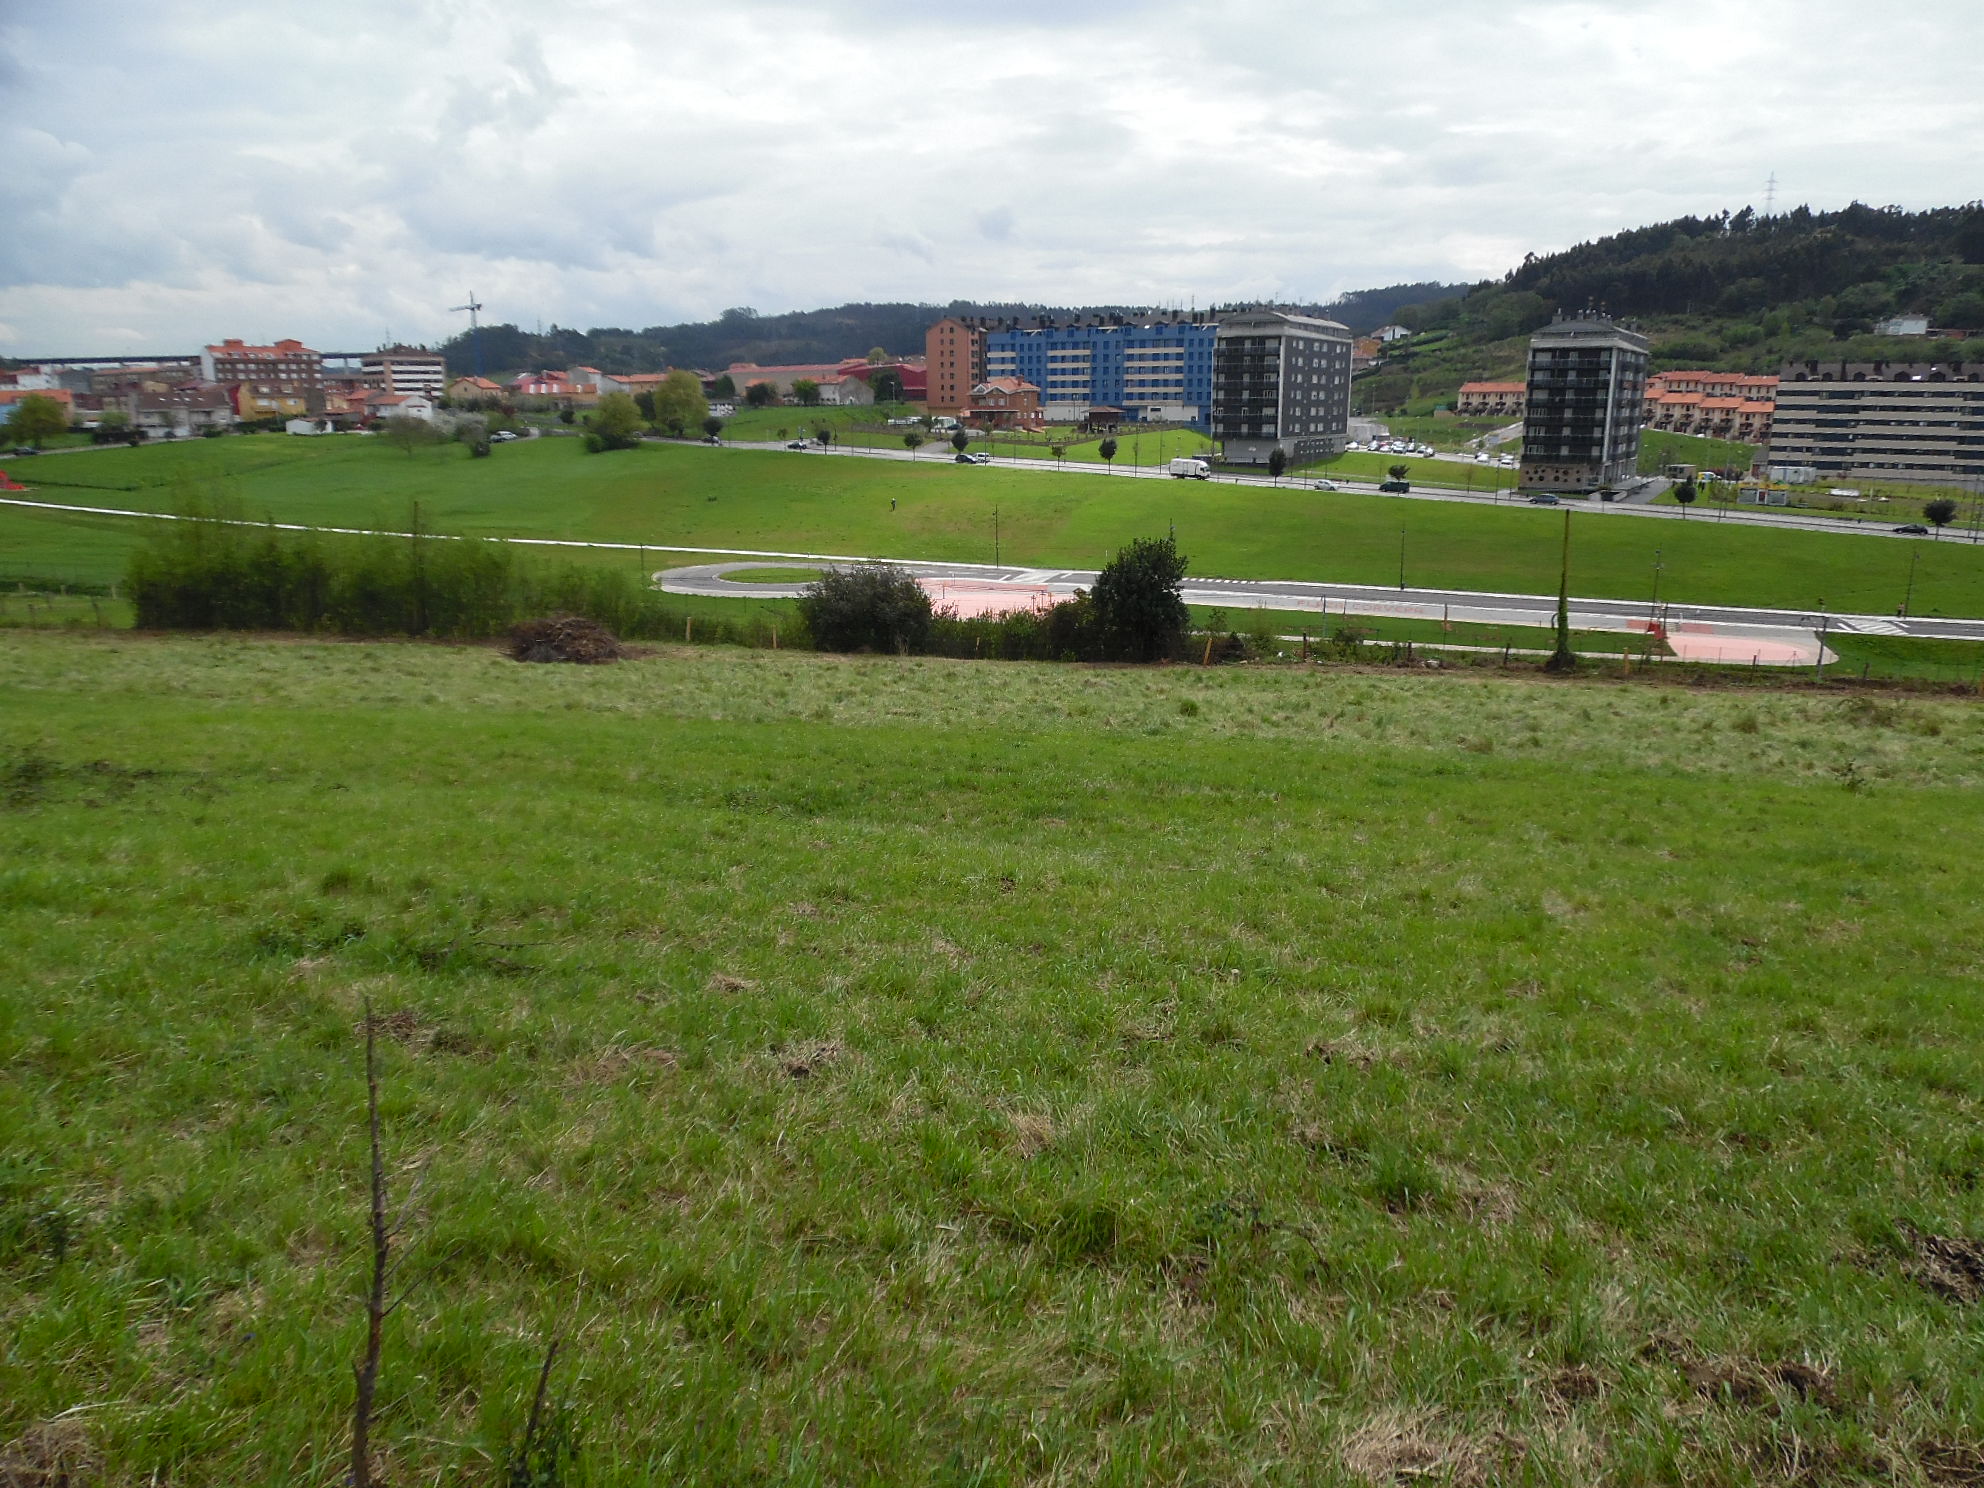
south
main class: Grassland
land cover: Grassland without tree/shrub cover
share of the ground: > 75 %
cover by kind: herbaceous plants 100 %
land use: Agriculture (excluding fallow land and kitchen gardens)
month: April
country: ES
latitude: 43.5383
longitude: -5.8940
